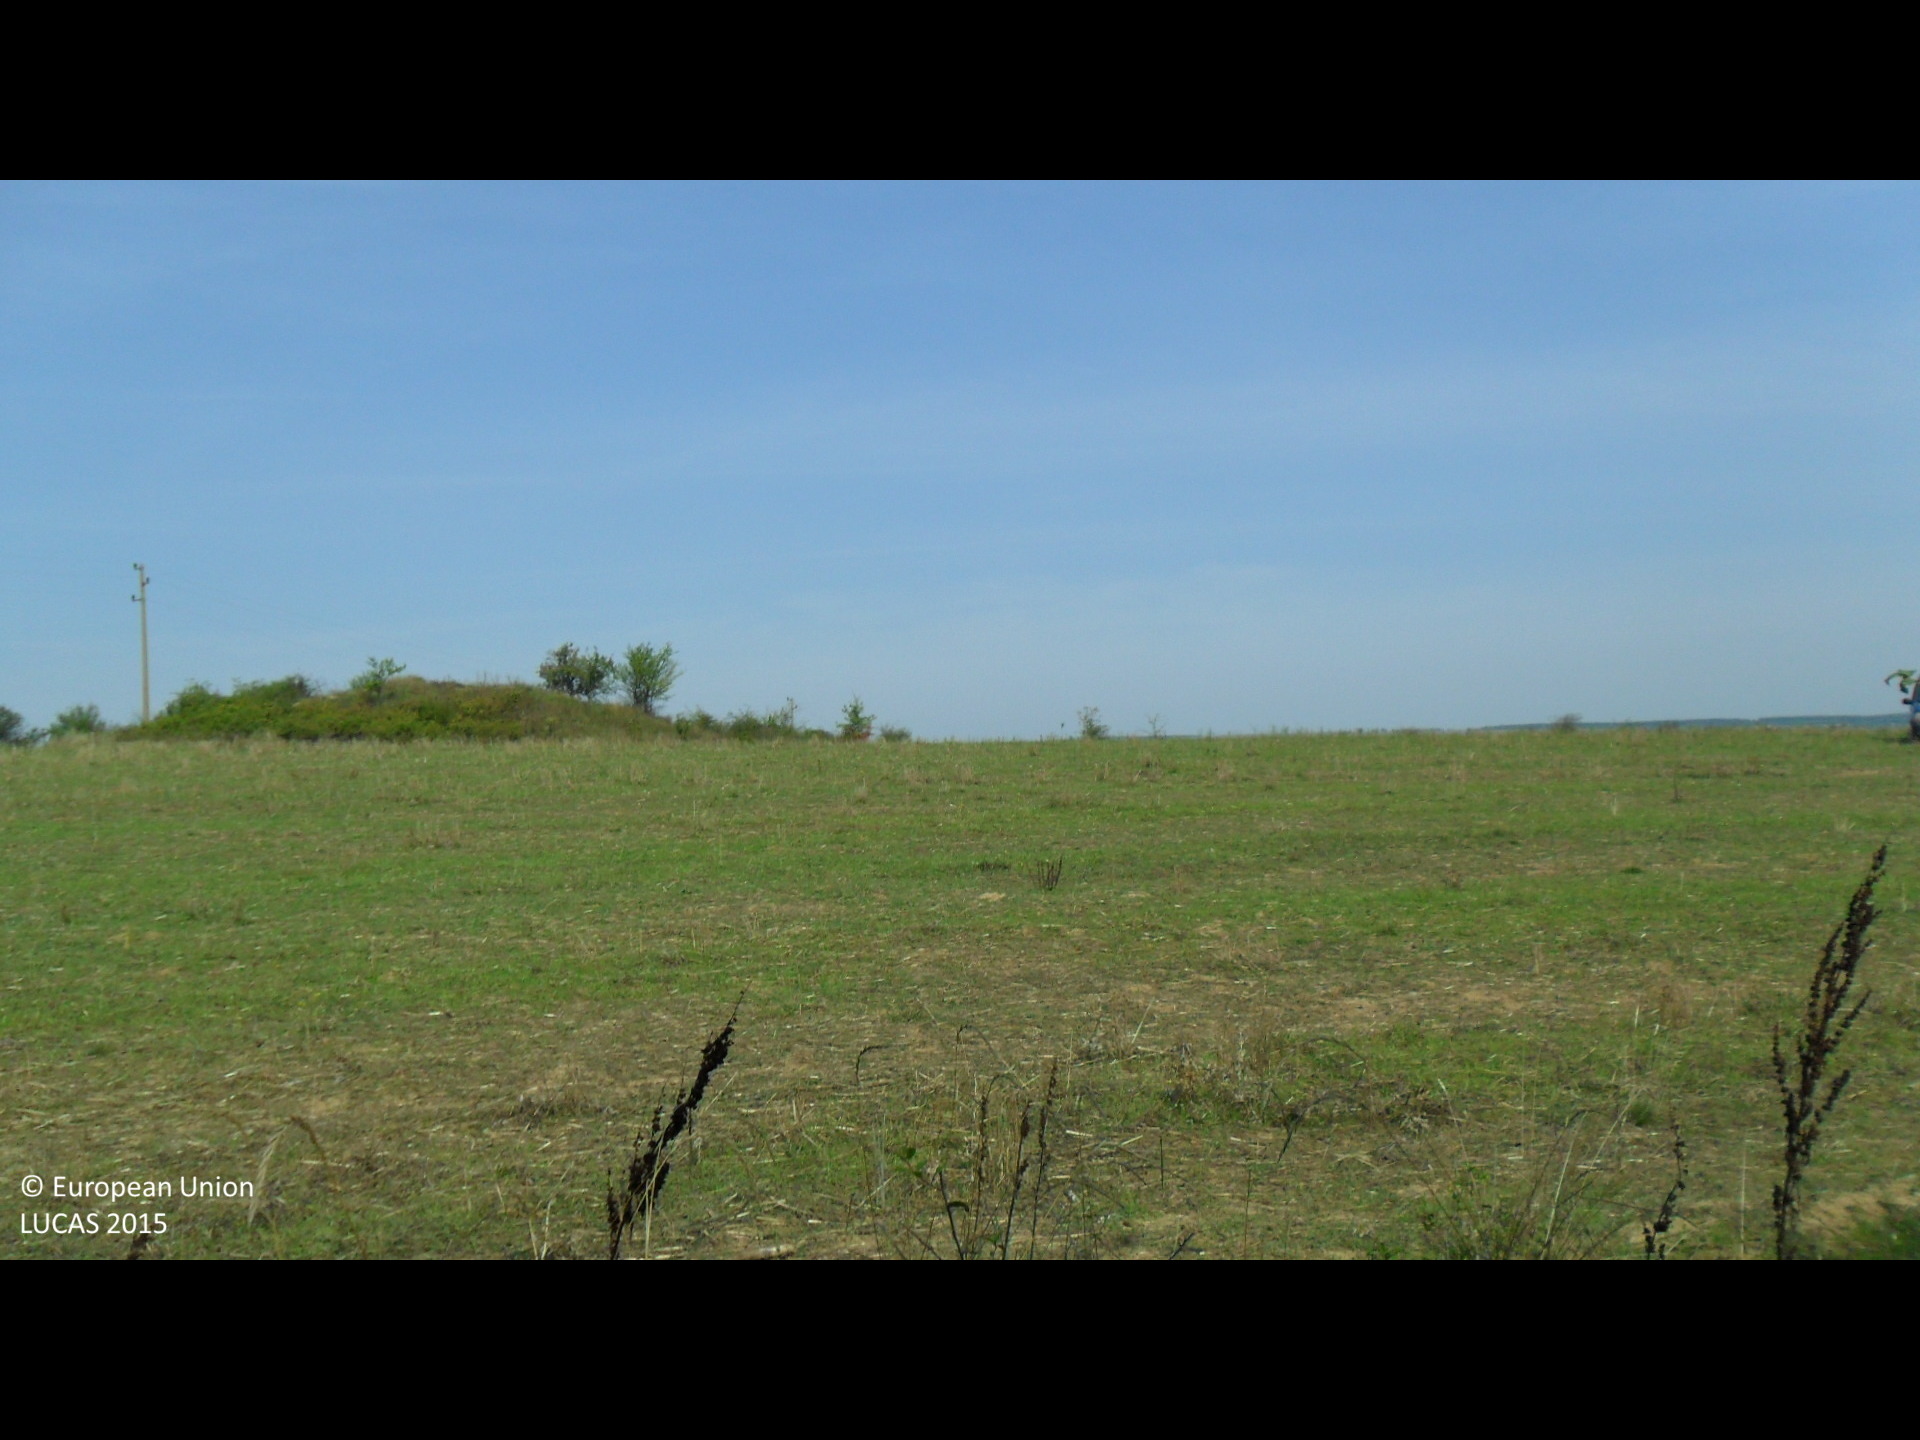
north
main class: Shrubland
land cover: Shrubland with sparse tree cover
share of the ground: > 75 %
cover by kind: shrubs 95 %, broadleaved forest trees 5 %
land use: Semi-natural and natural areas not in use
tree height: < 5 m
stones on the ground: < 10 %
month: September
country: BG
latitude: 43.0315
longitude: 26.5334
